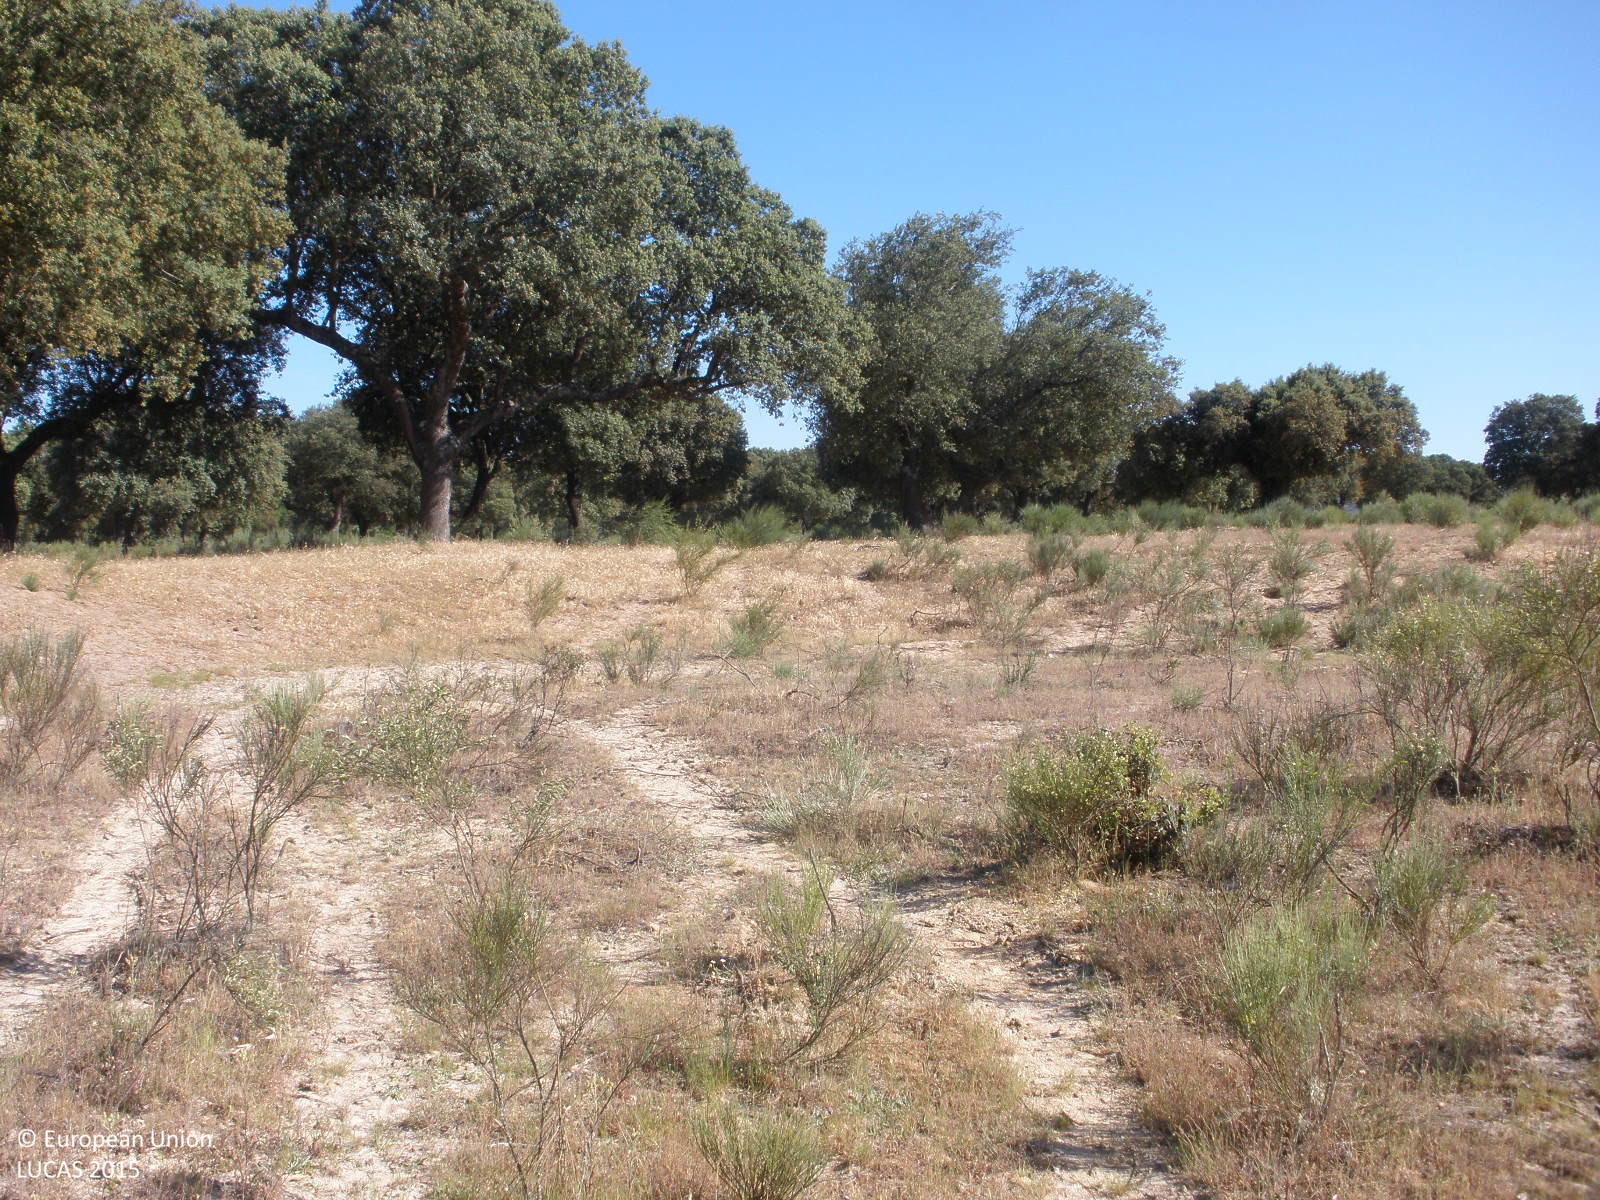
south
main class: Shrubland
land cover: Shrubland with sparse tree cover
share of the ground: 50 - 75 %
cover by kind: shrubs 50 %, herbaceous plants 35 %, consolidated bare surface 10 %, broadleaved forest trees 5 %
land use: Agriculture (excluding fallow land and kitchen gardens)
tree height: < 5 m
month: June
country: ES
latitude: 40.5021
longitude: -6.6947
